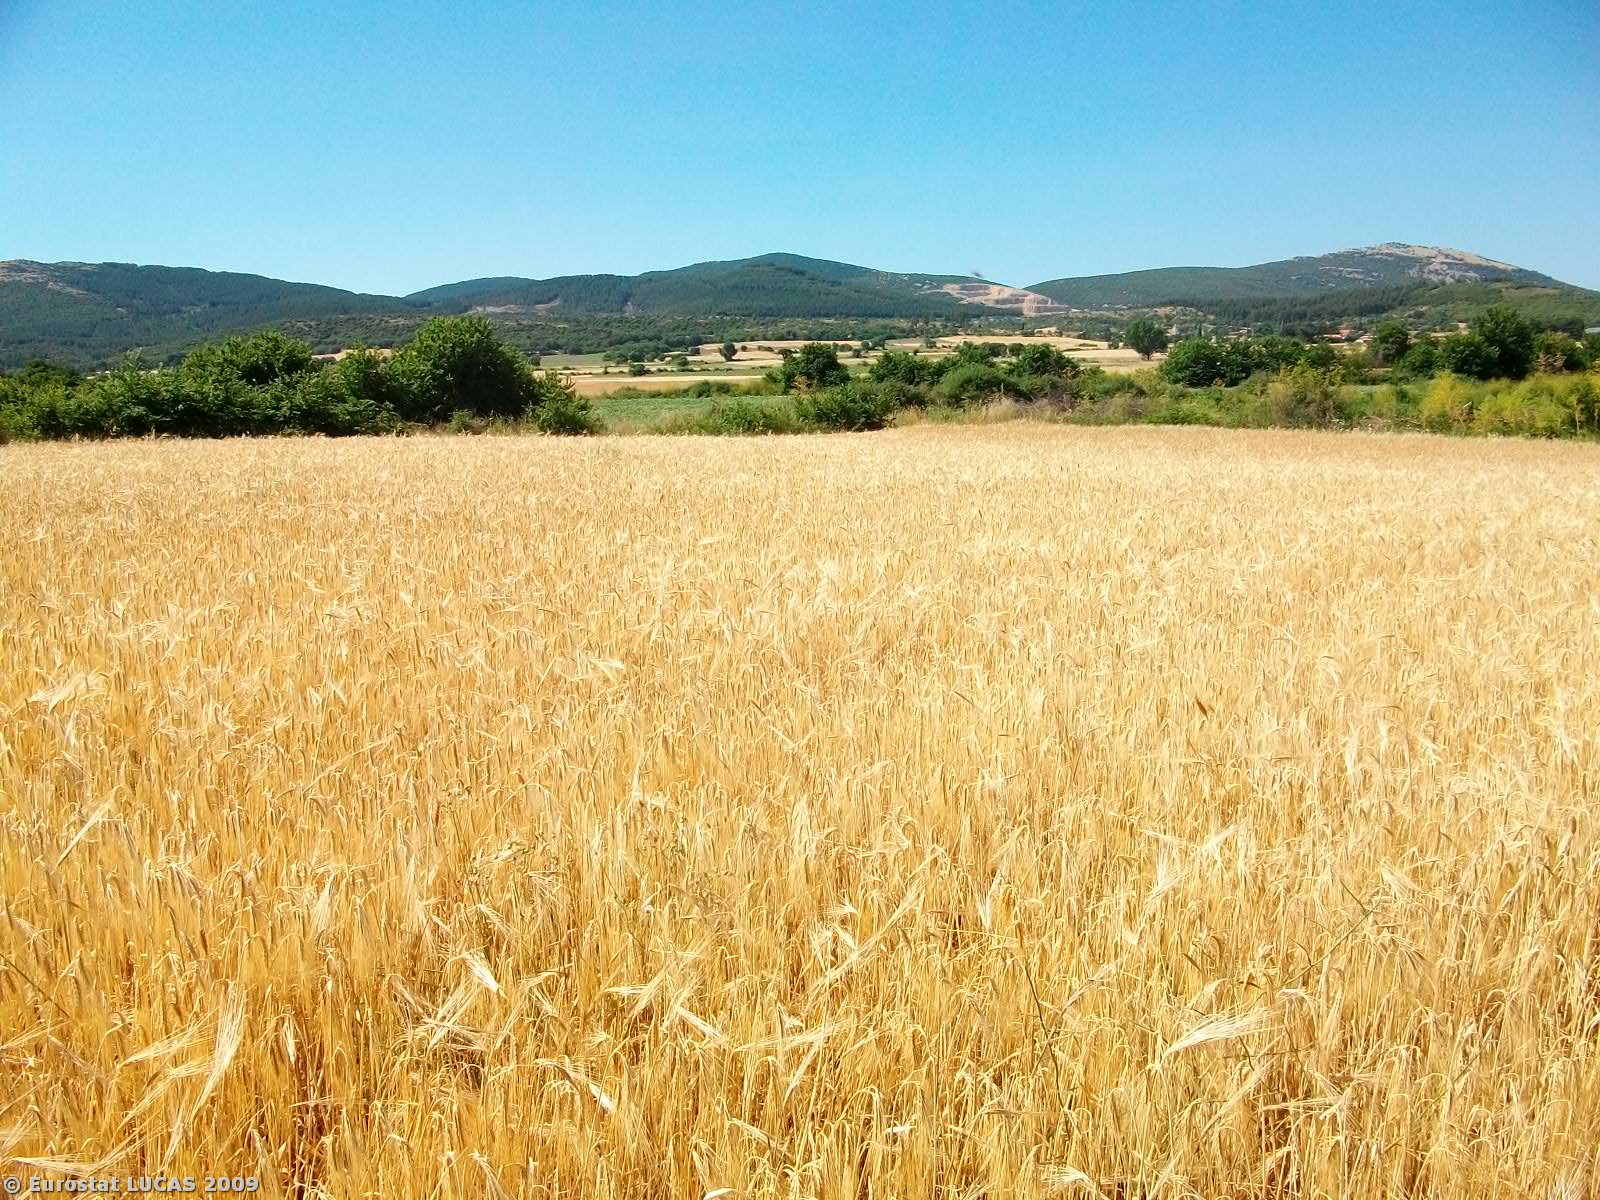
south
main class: Cropland
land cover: Barley
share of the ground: > 75 %
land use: Agriculture (excluding fallow land and kitchen gardens)
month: June
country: GR
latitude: 41.0159
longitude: 25.4736
